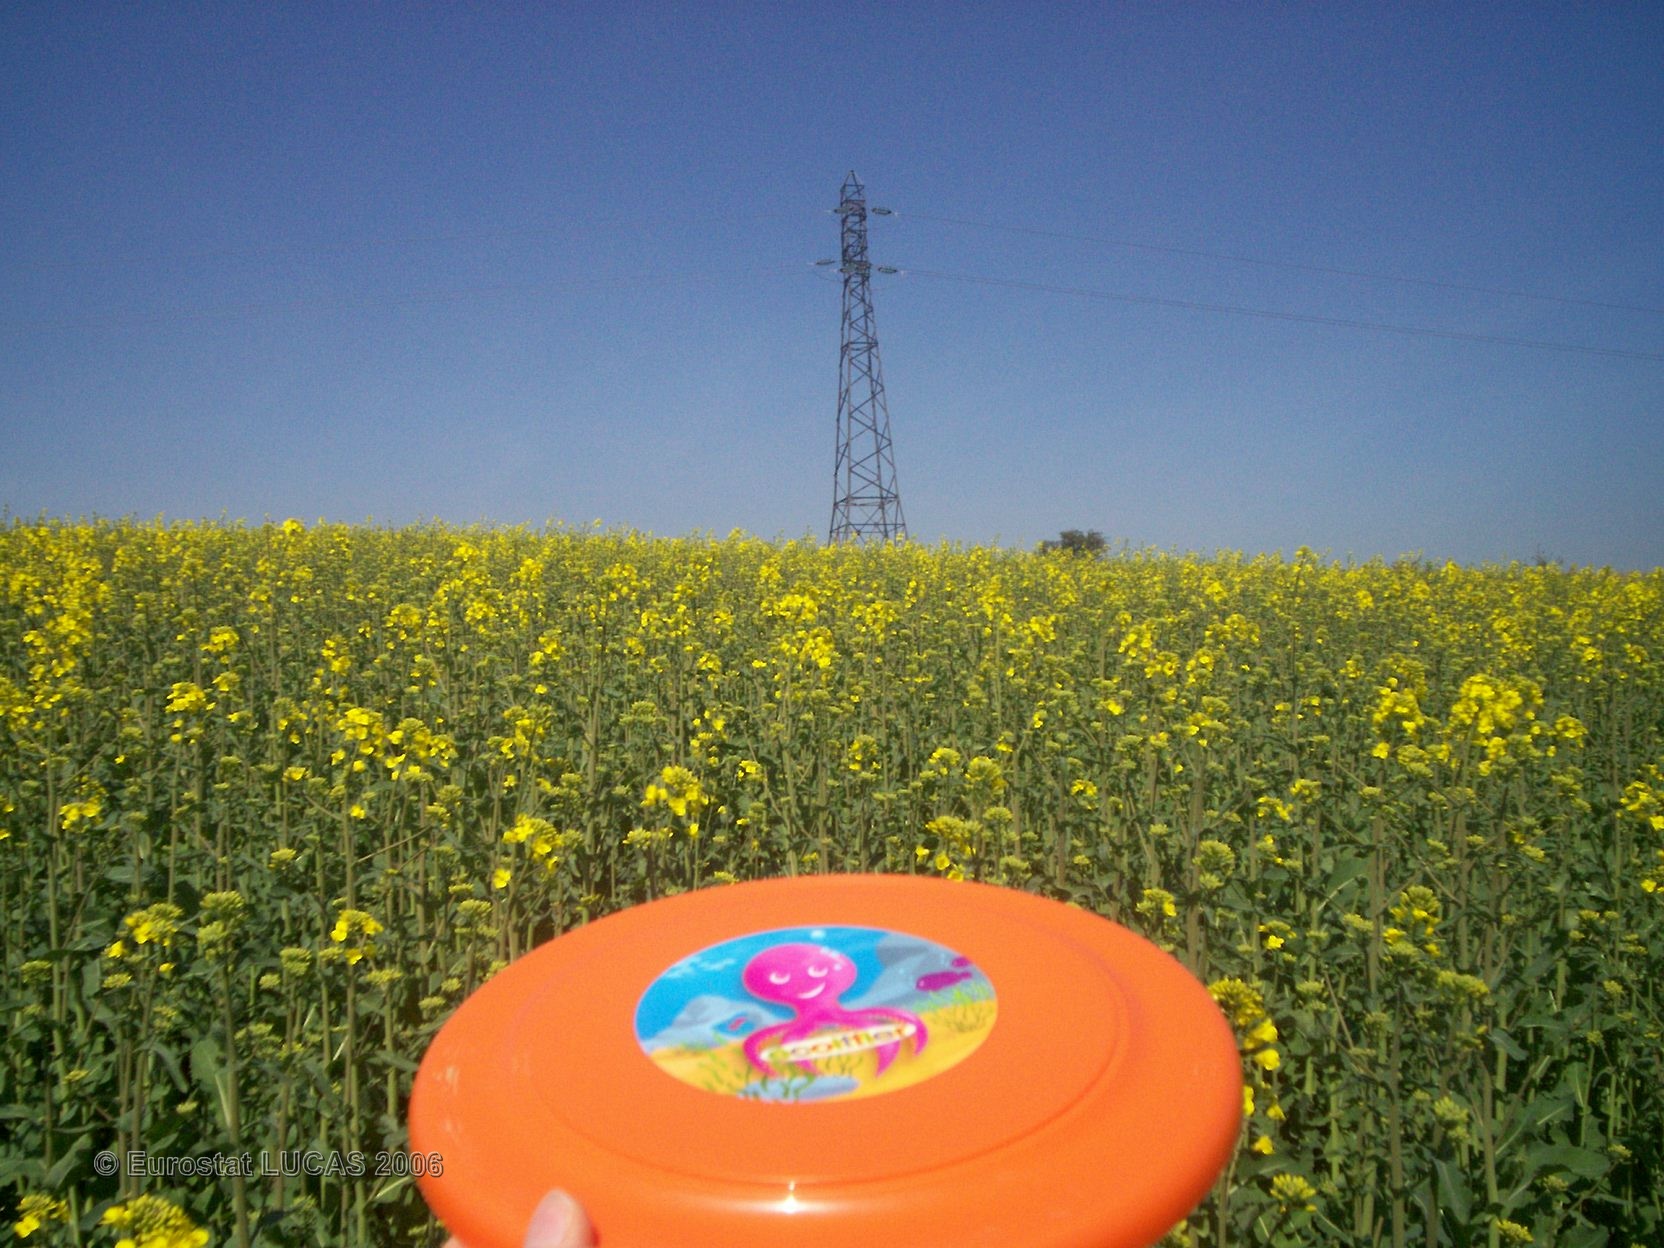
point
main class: Cropland
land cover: Rape and turnip rape
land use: Agriculture (excluding fallow land and kitchen gardens)
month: April
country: FR
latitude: 45.4678
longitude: 4.8242
